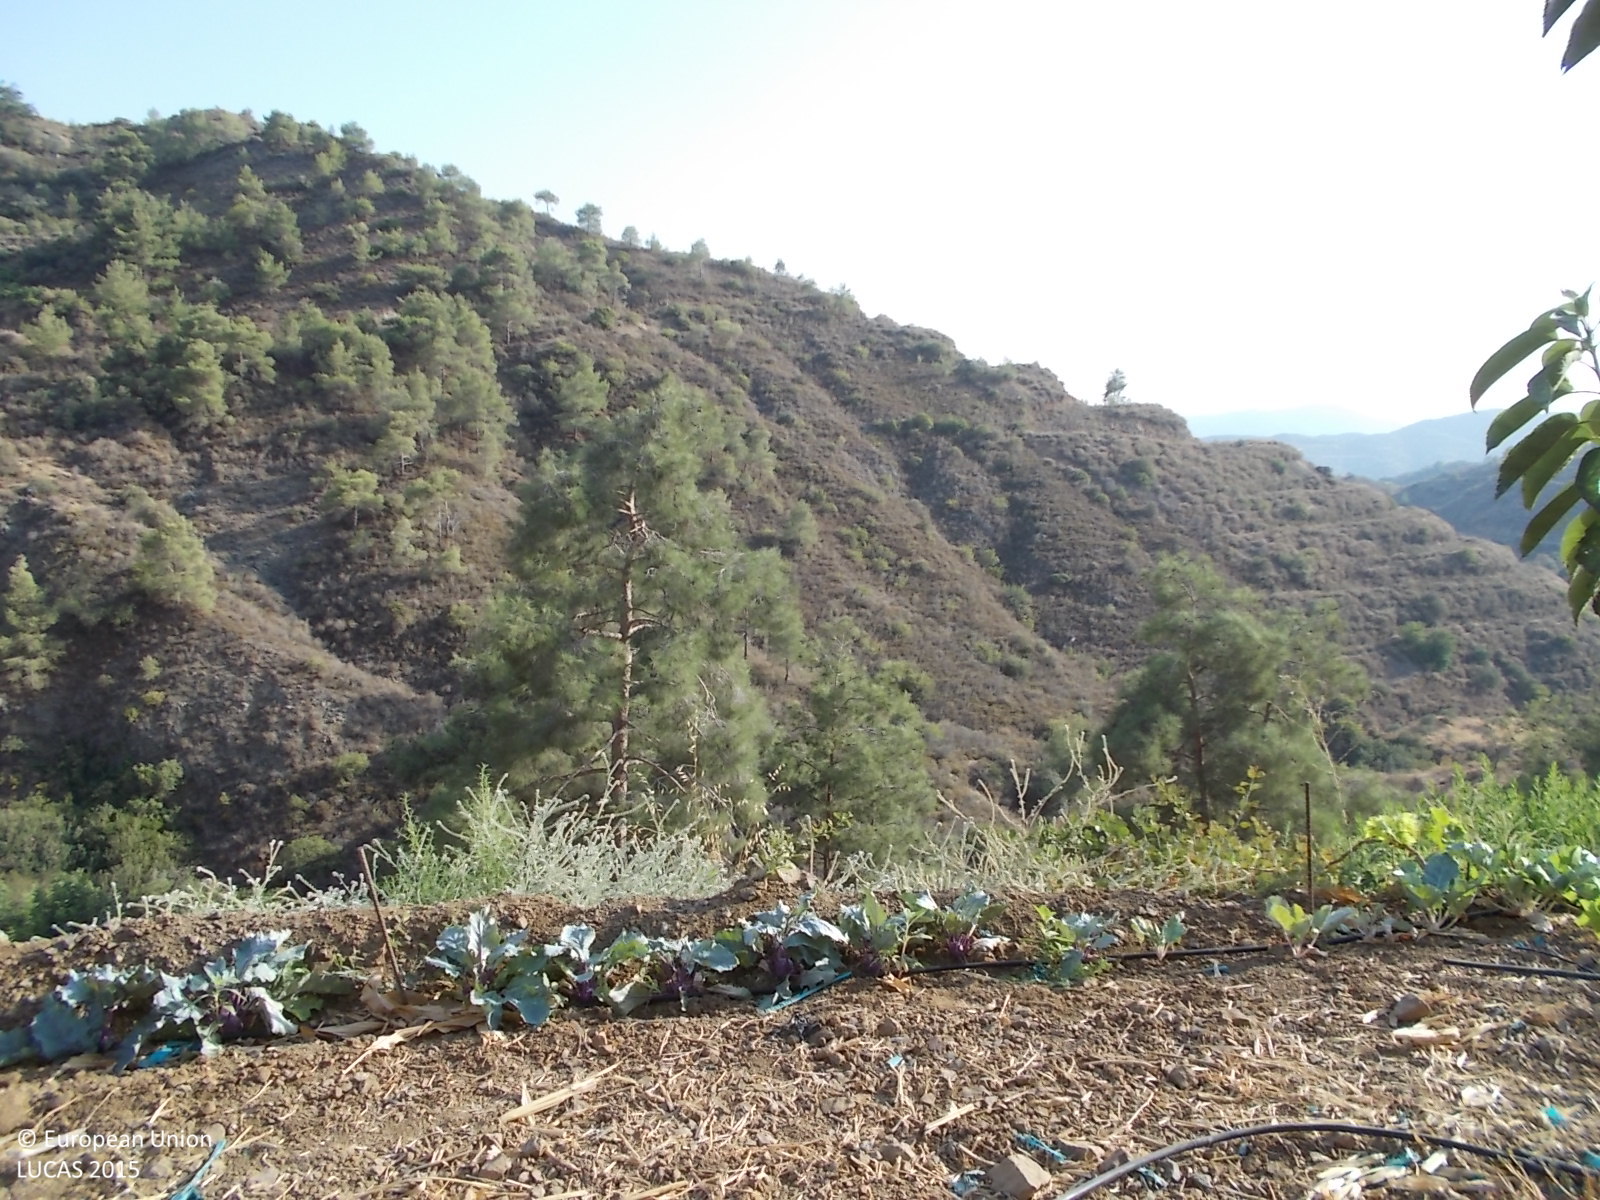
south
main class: Cropland
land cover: Tomatoes
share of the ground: 10 - 25 %
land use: Agriculture (excluding fallow land and kitchen gardens)
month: April
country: CY
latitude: 34.8778
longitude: 33.1849
